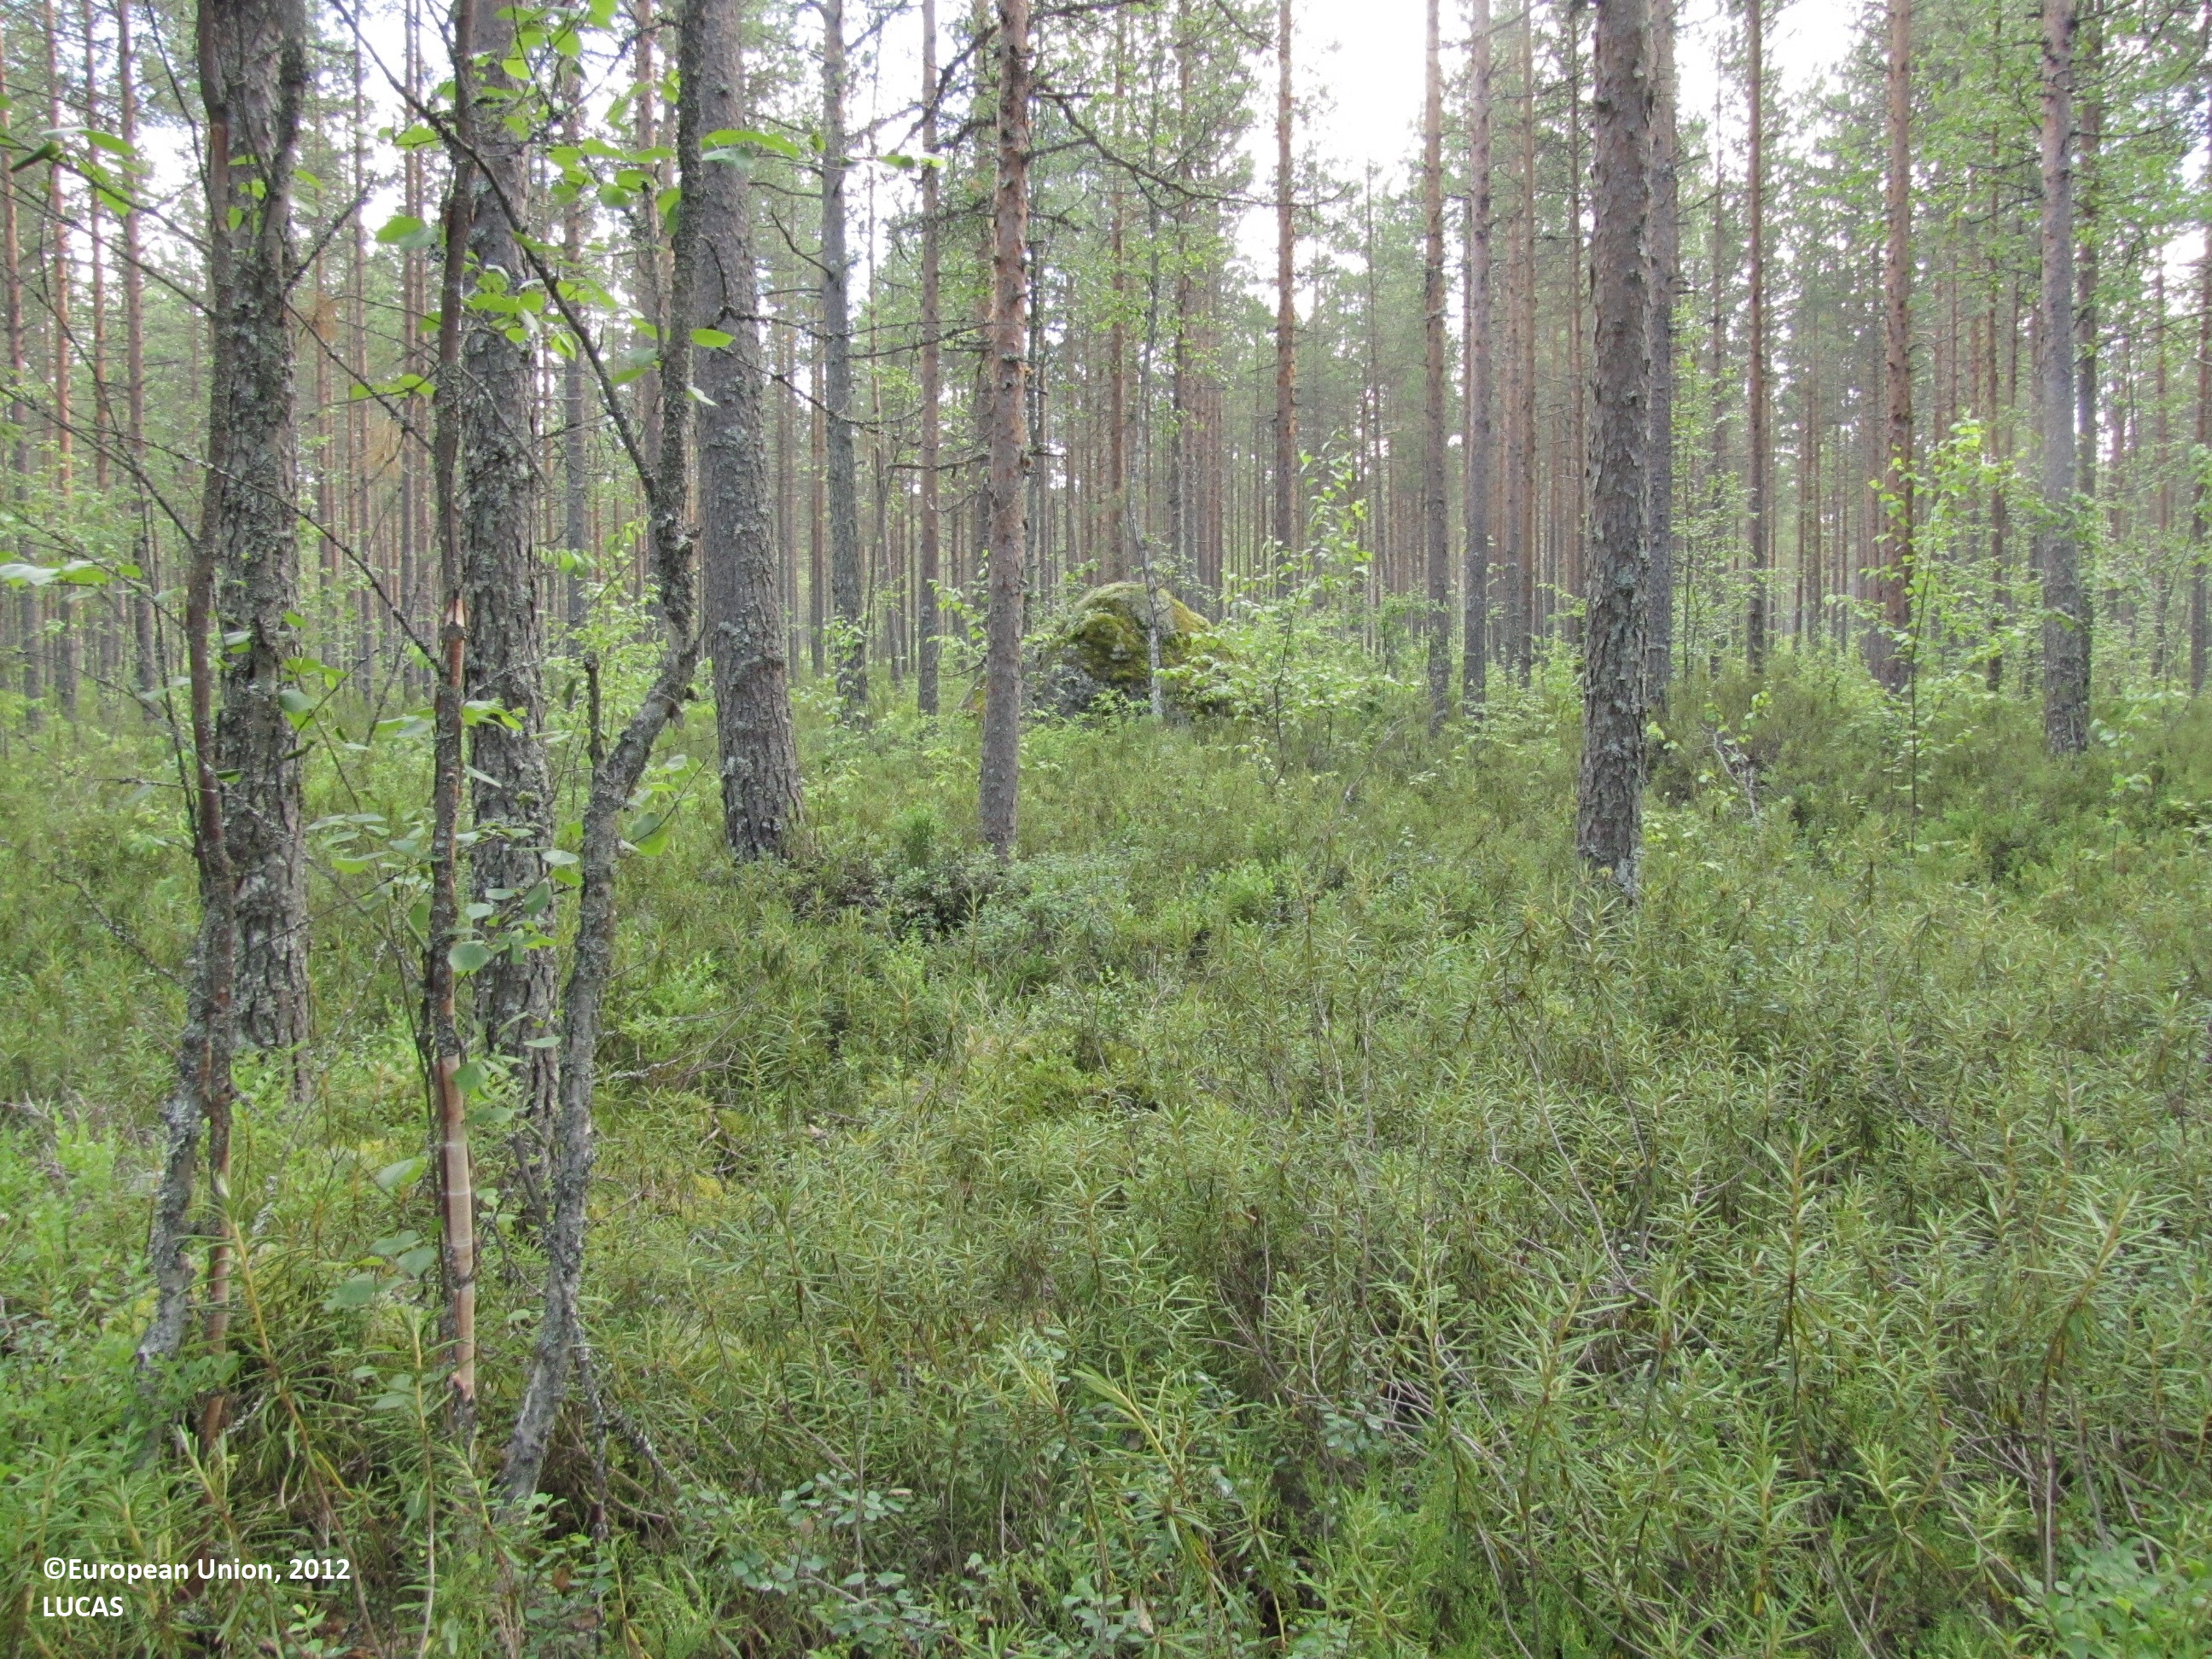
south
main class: Woodland
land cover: Pine dominated coniferous woodland
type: mire and swamp forests
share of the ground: 50 - 75 %
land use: Forestry
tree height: > 5 m
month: July
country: FI
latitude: 62.3672
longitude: 23.5044
